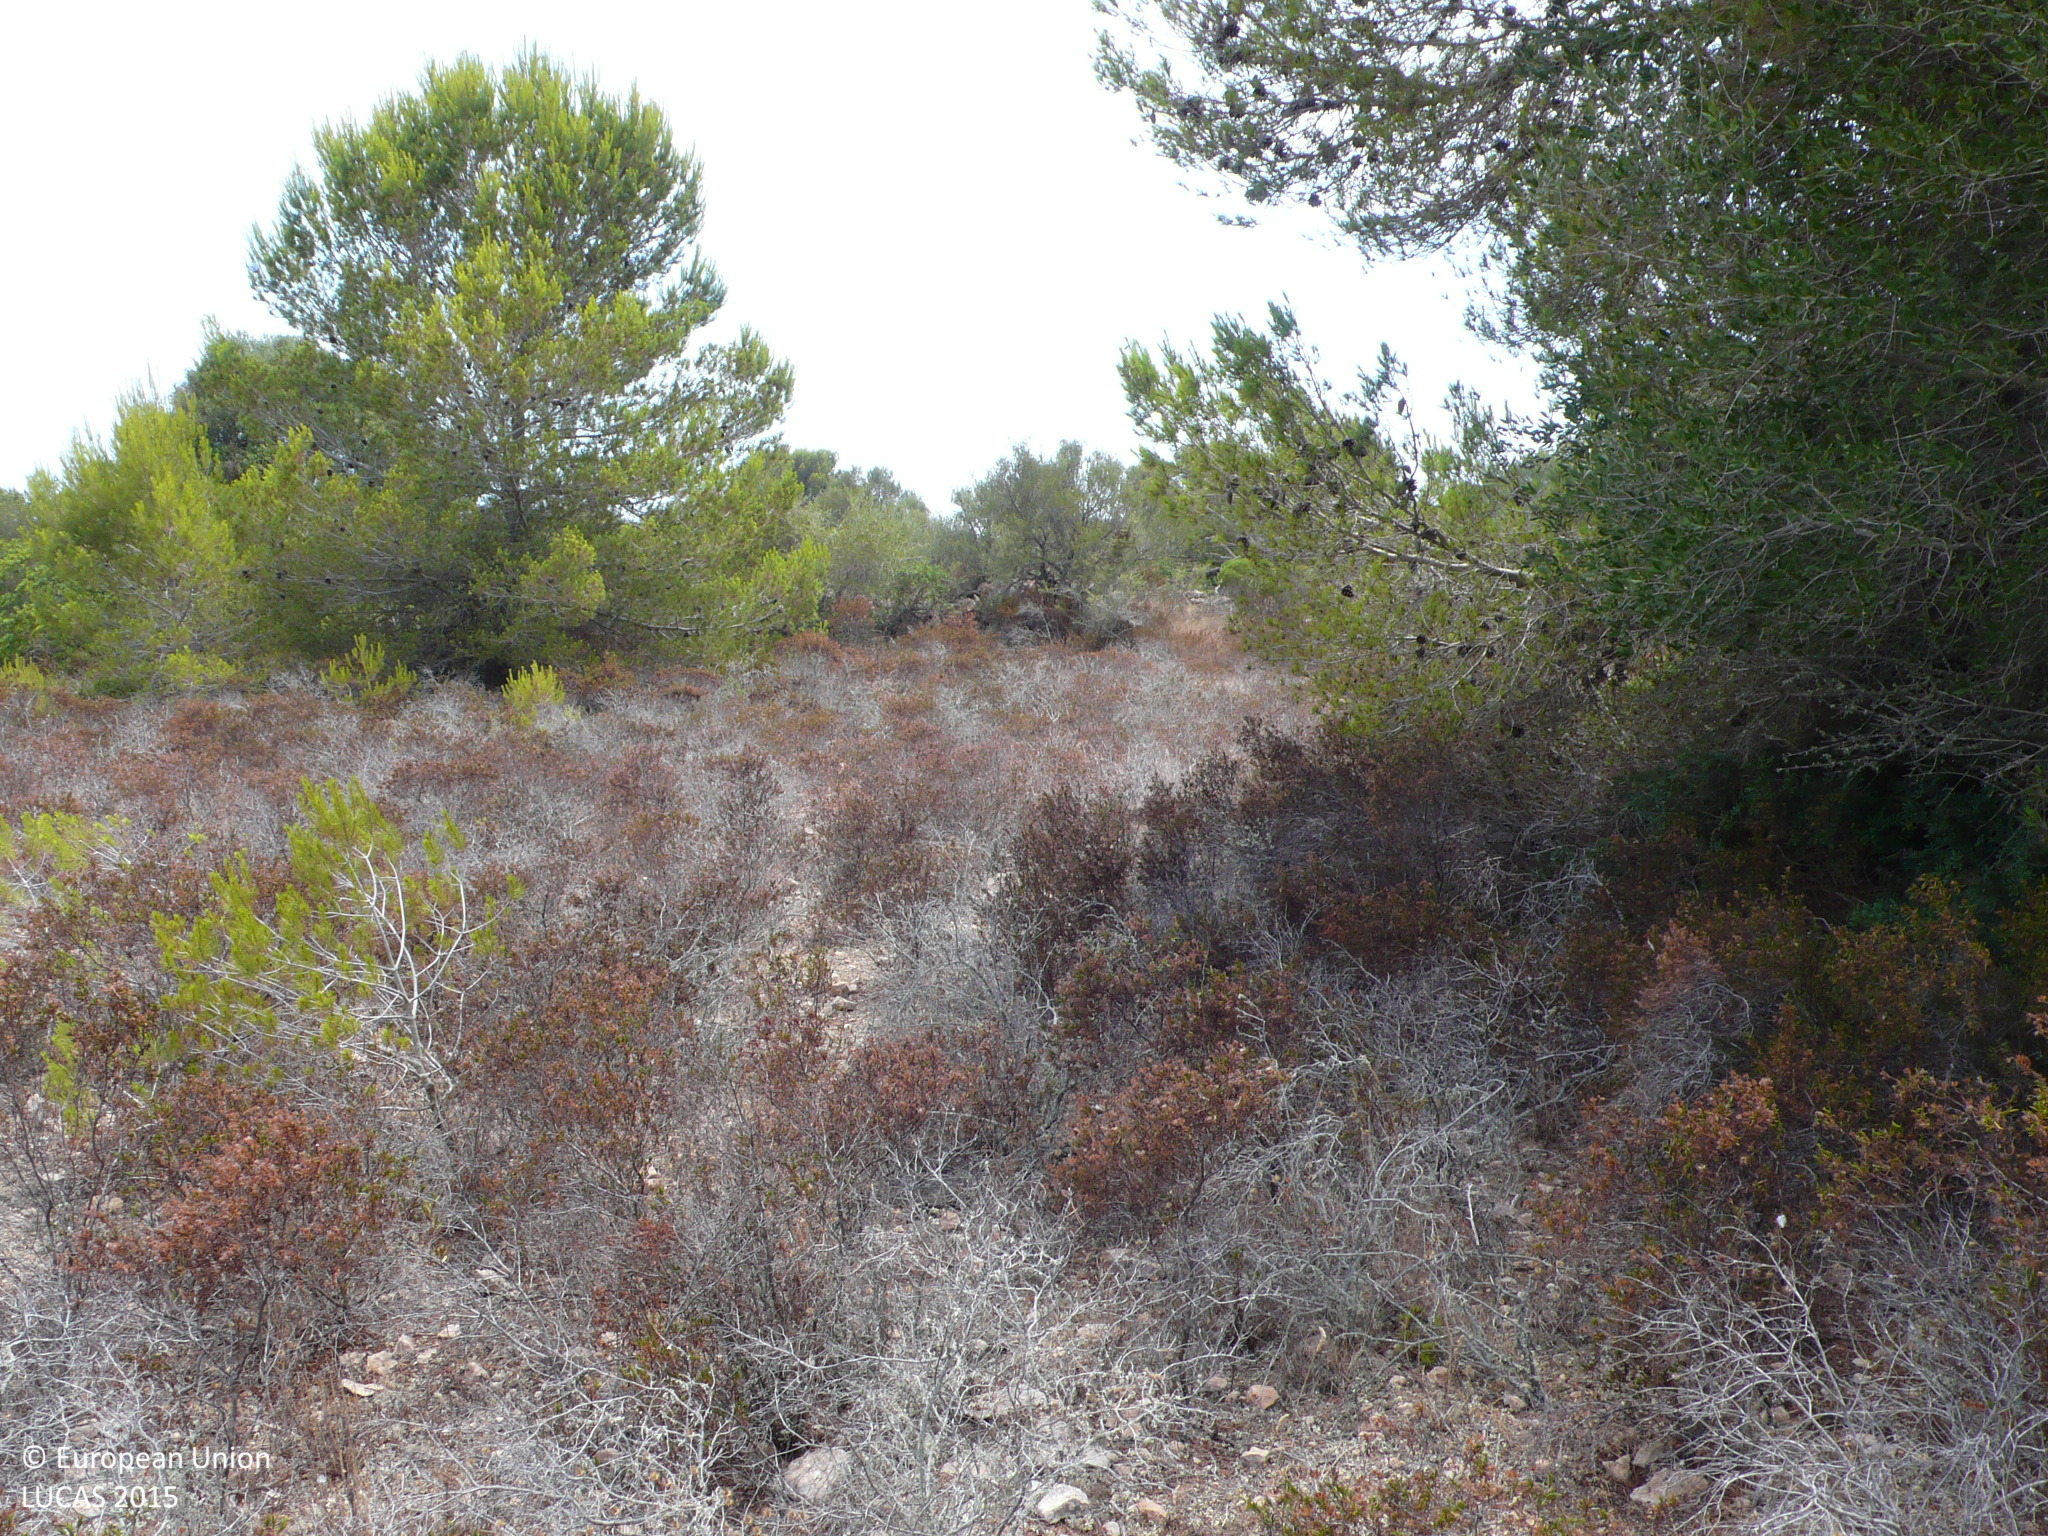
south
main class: Woodland
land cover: Pine dominated mixed woodland
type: coniferous forest of the mediterranean region
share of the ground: 10 - 25 %
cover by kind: shrubs 60 %, coniferous forest trees 20 %, broadleaved forest trees 15 %, consolidated bare surface 5 %
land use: Semi-natural and natural areas not in use
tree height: > 5 m
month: July
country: ES
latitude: 39.3683
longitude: 2.8238
